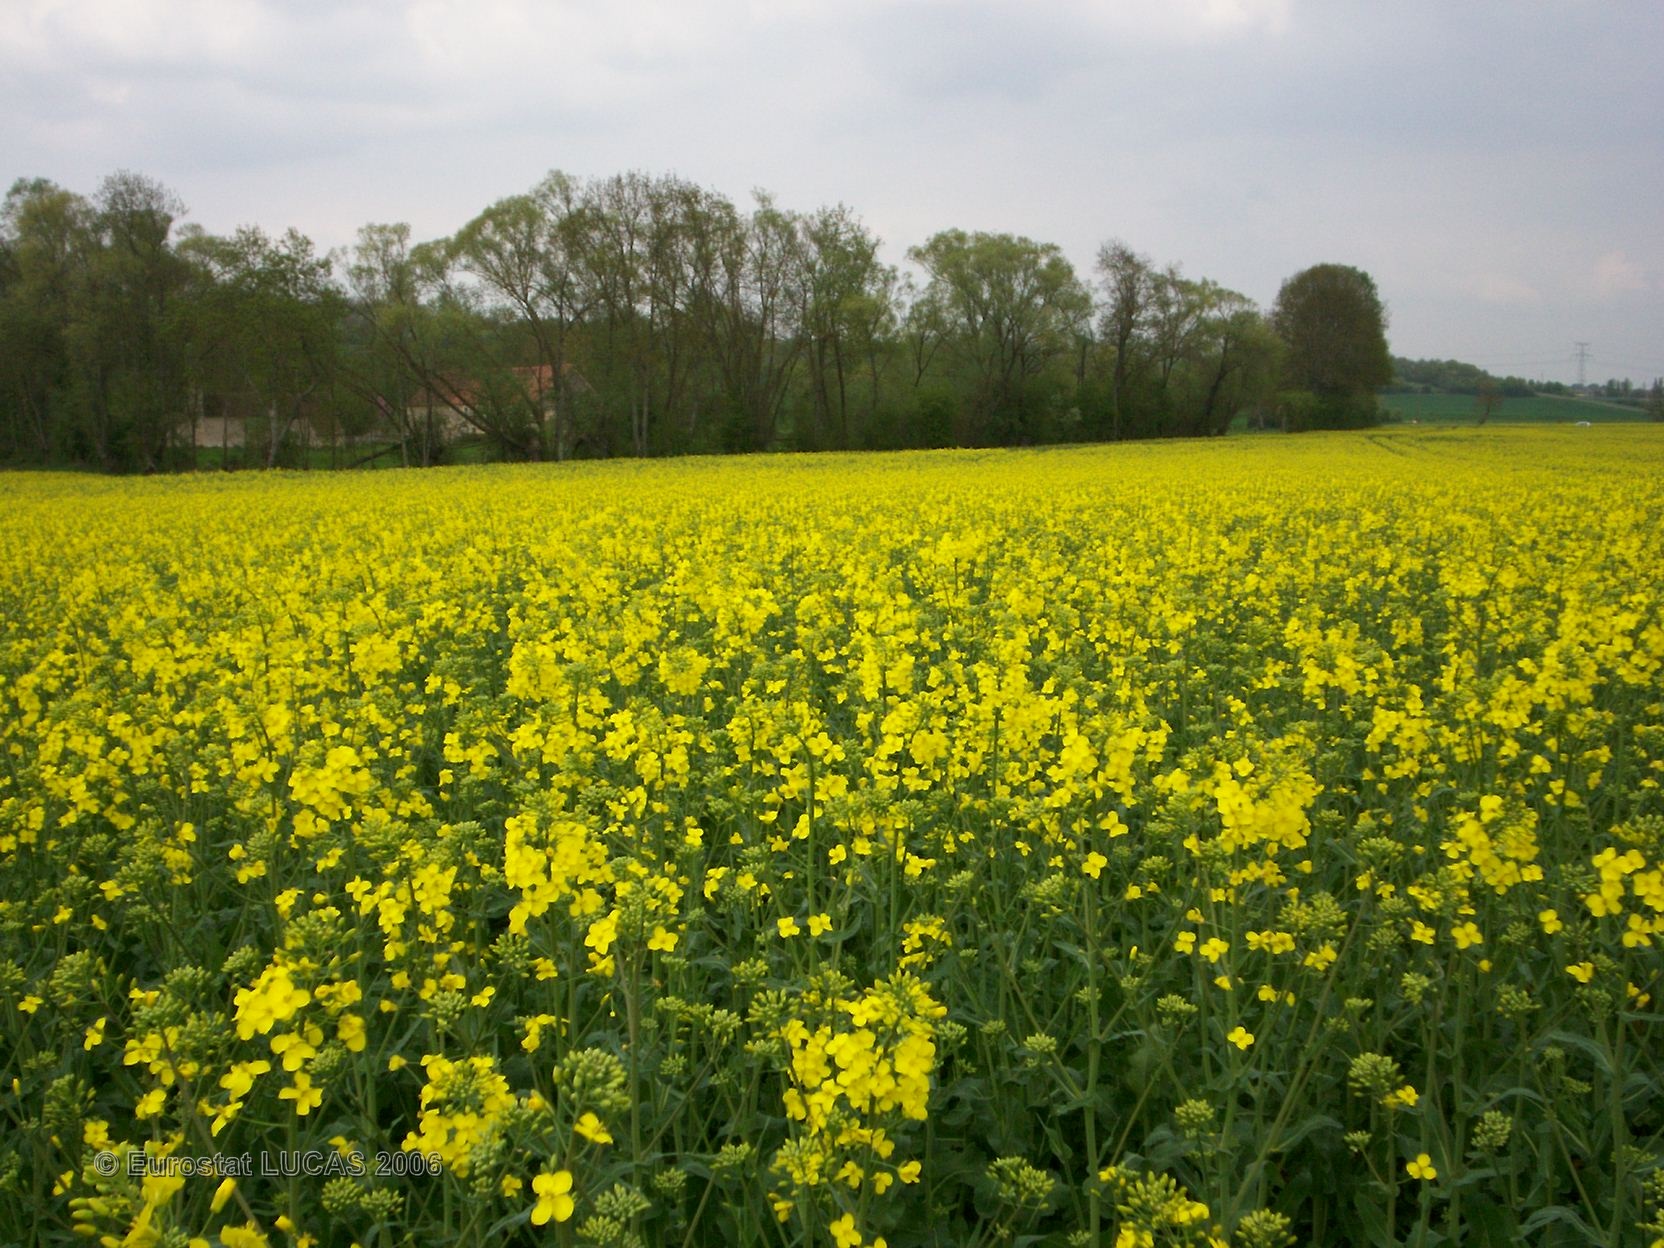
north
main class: Cropland
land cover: Rape and turnip rape
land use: Agriculture (excluding fallow land and kitchen gardens)
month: April
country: FR
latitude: 47.1548
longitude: 3.0447
